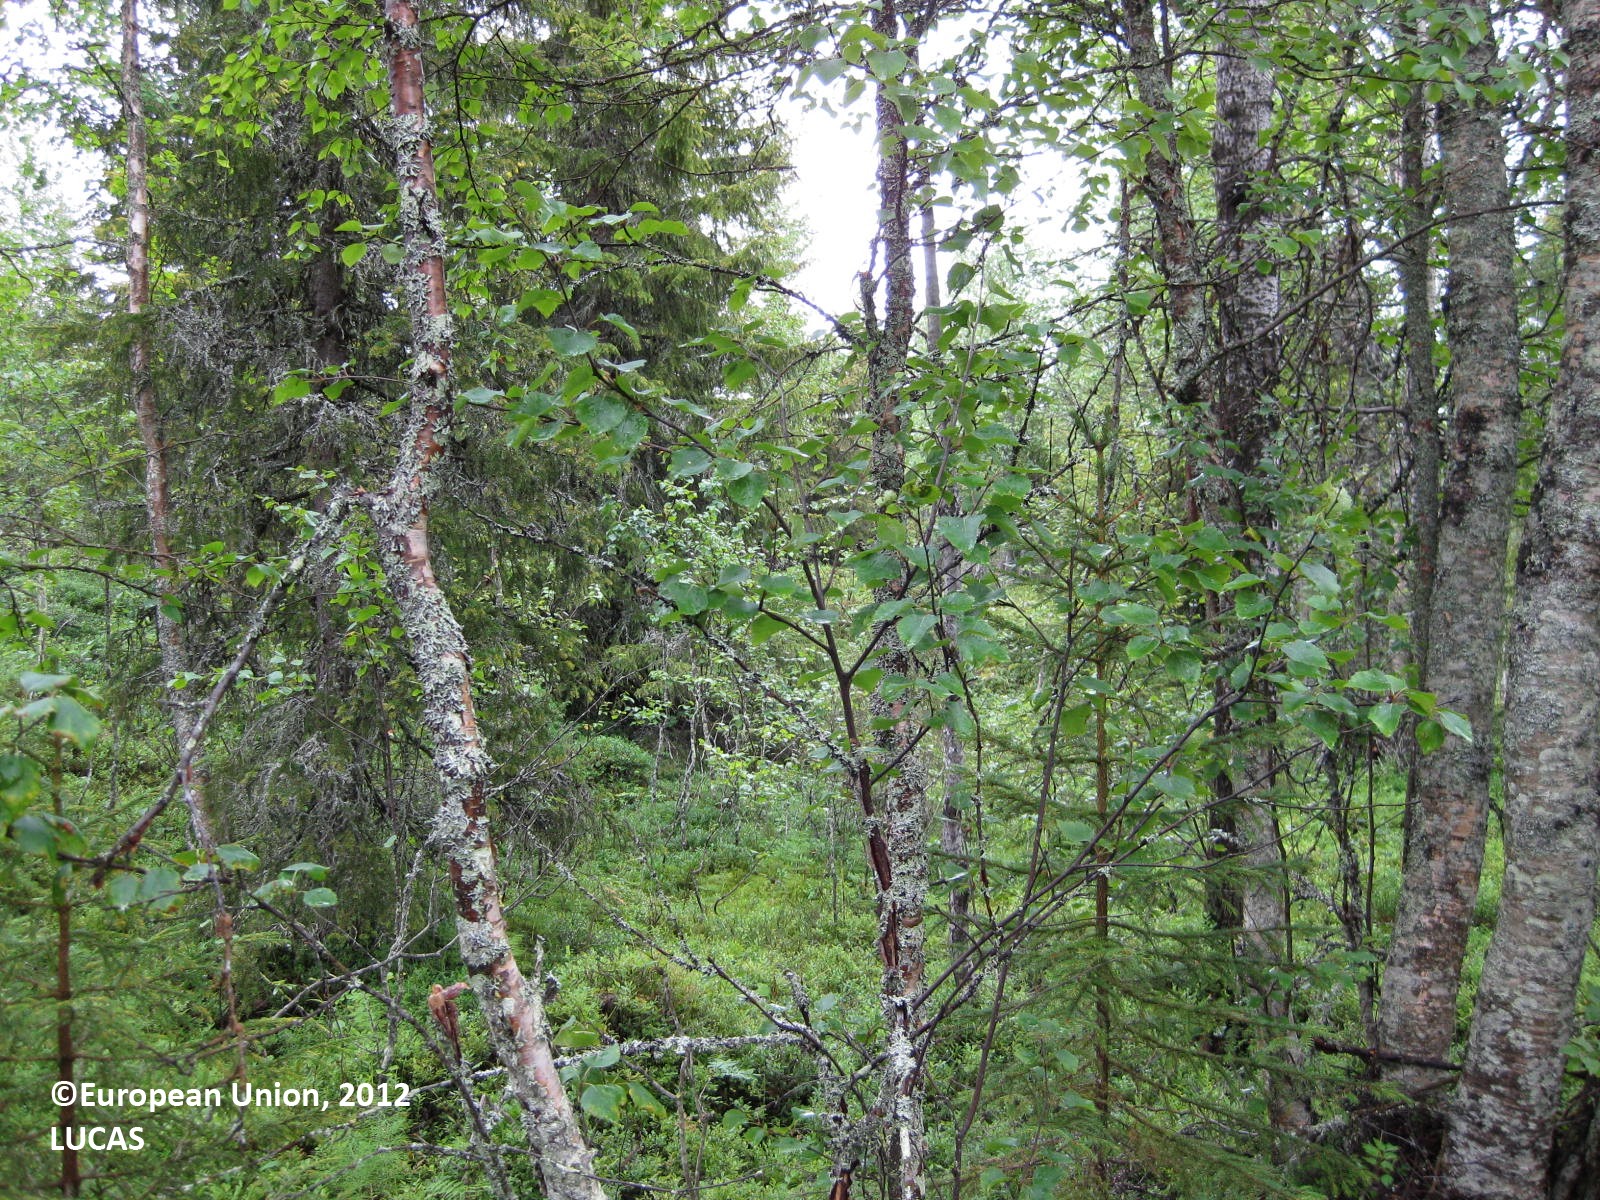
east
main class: Woodland
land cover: Spruce dominated mixed woodland
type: boreal forest
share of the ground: 50 - 75 %
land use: Forestry
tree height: > 5 m
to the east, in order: Spruce dominated mixed woodland; Ditches and canals; Other mixed woodland; Tracks; Spruce dominated mixed woodland; Ditches and canals; Spruce dominated mixed woodland; Ditches and canals; Spruce dominated mixed woodland; Ditches and canals; Spruce dominated mixed woodland; Ditches and canals; Spruce dominated mixed woodland; Ditches and canals; Spruce dominated mixed woodland; Ditches and canals; Spruce dominated mixed woodland; Ditches and canals; Spruce dominated mixed woodland; Ditches and canals; Spruce dominated mixed woodland; Ditches and canals; Spruce dominated mixed woodland; Ditches and canals; Spruce dominated mixed woodland
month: July
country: FI
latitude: 65.8735
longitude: 28.5071
